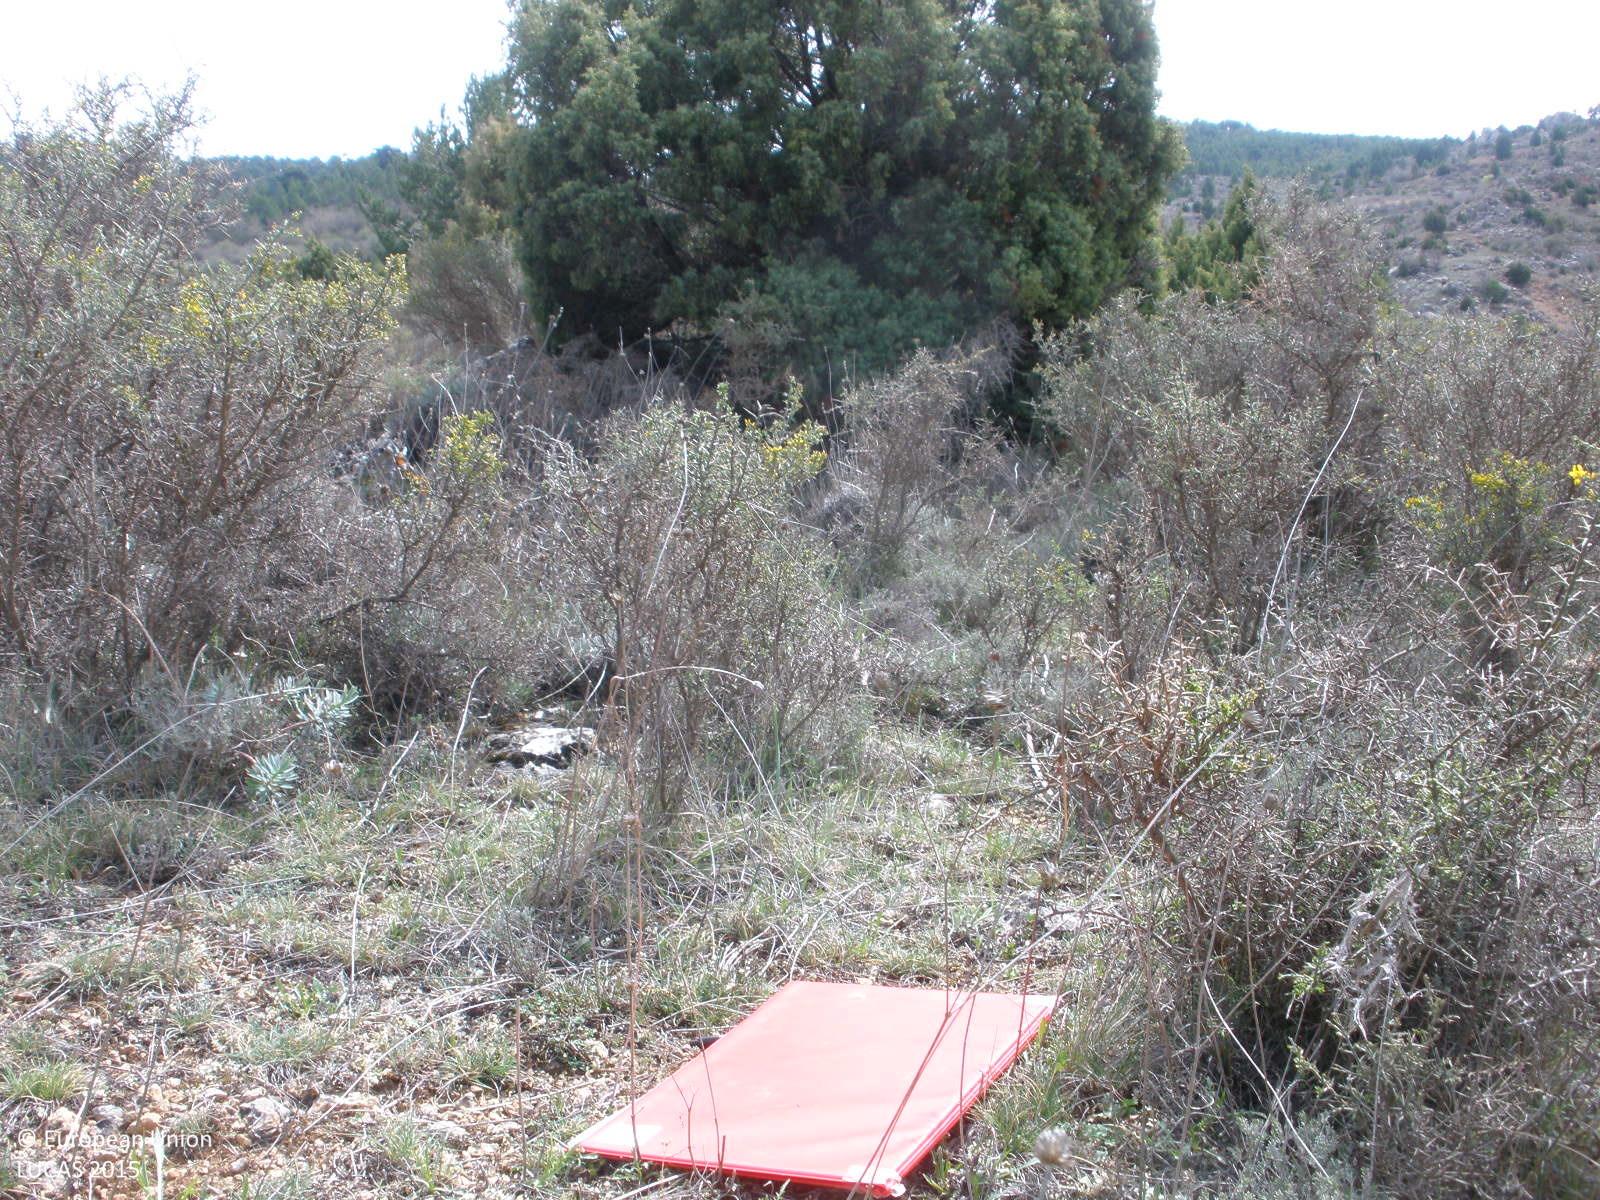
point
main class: Shrubland
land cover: Shrubland with sparse tree cover
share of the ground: > 75 %
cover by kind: shrubs 60 %, herbaceous plants 20 %, consolidated bare surface 15 %, coniferous forest trees 5 %
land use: Agriculture (excluding fallow land and kitchen gardens)
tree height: < 5 m
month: April
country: ES
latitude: 40.1541
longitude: -1.0317
